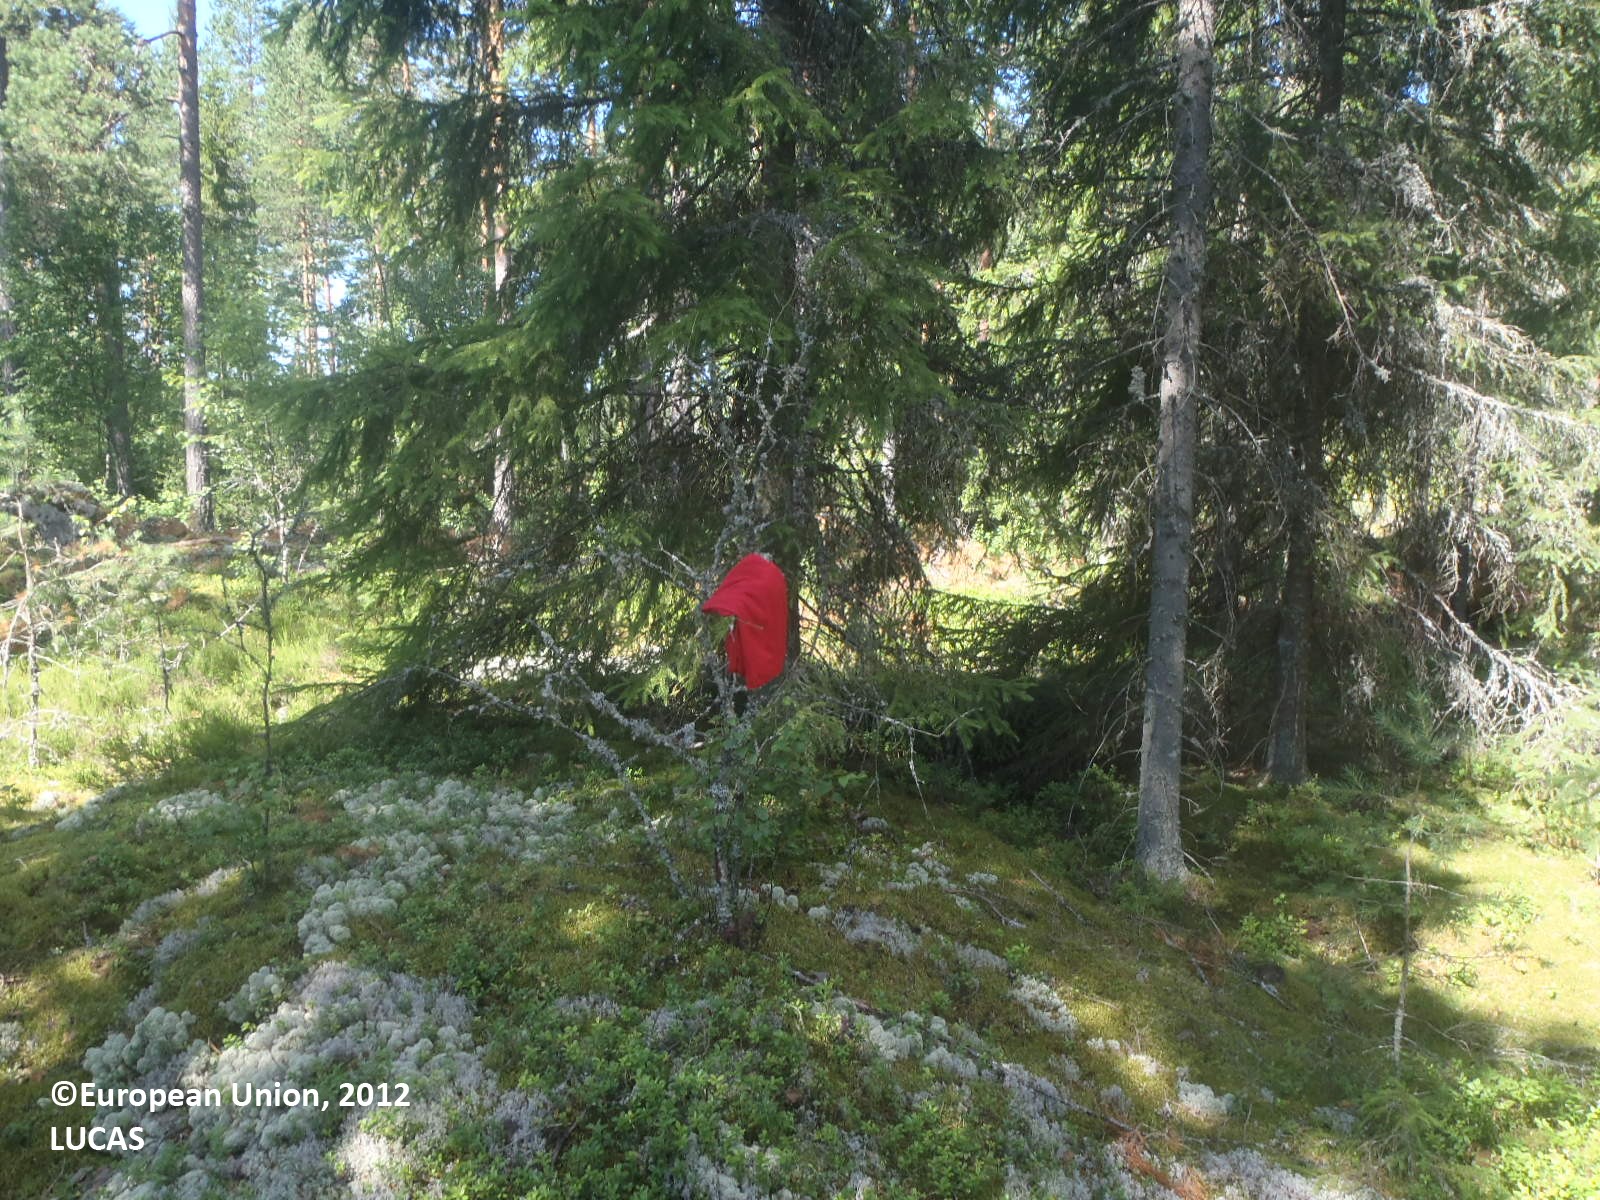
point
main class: Woodland
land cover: Spruce dominated coniferous woodland
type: boreal forest
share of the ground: 50 - 75 %
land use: Forestry
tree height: > 5 m
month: July
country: FI
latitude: 61.0291
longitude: 21.8472
